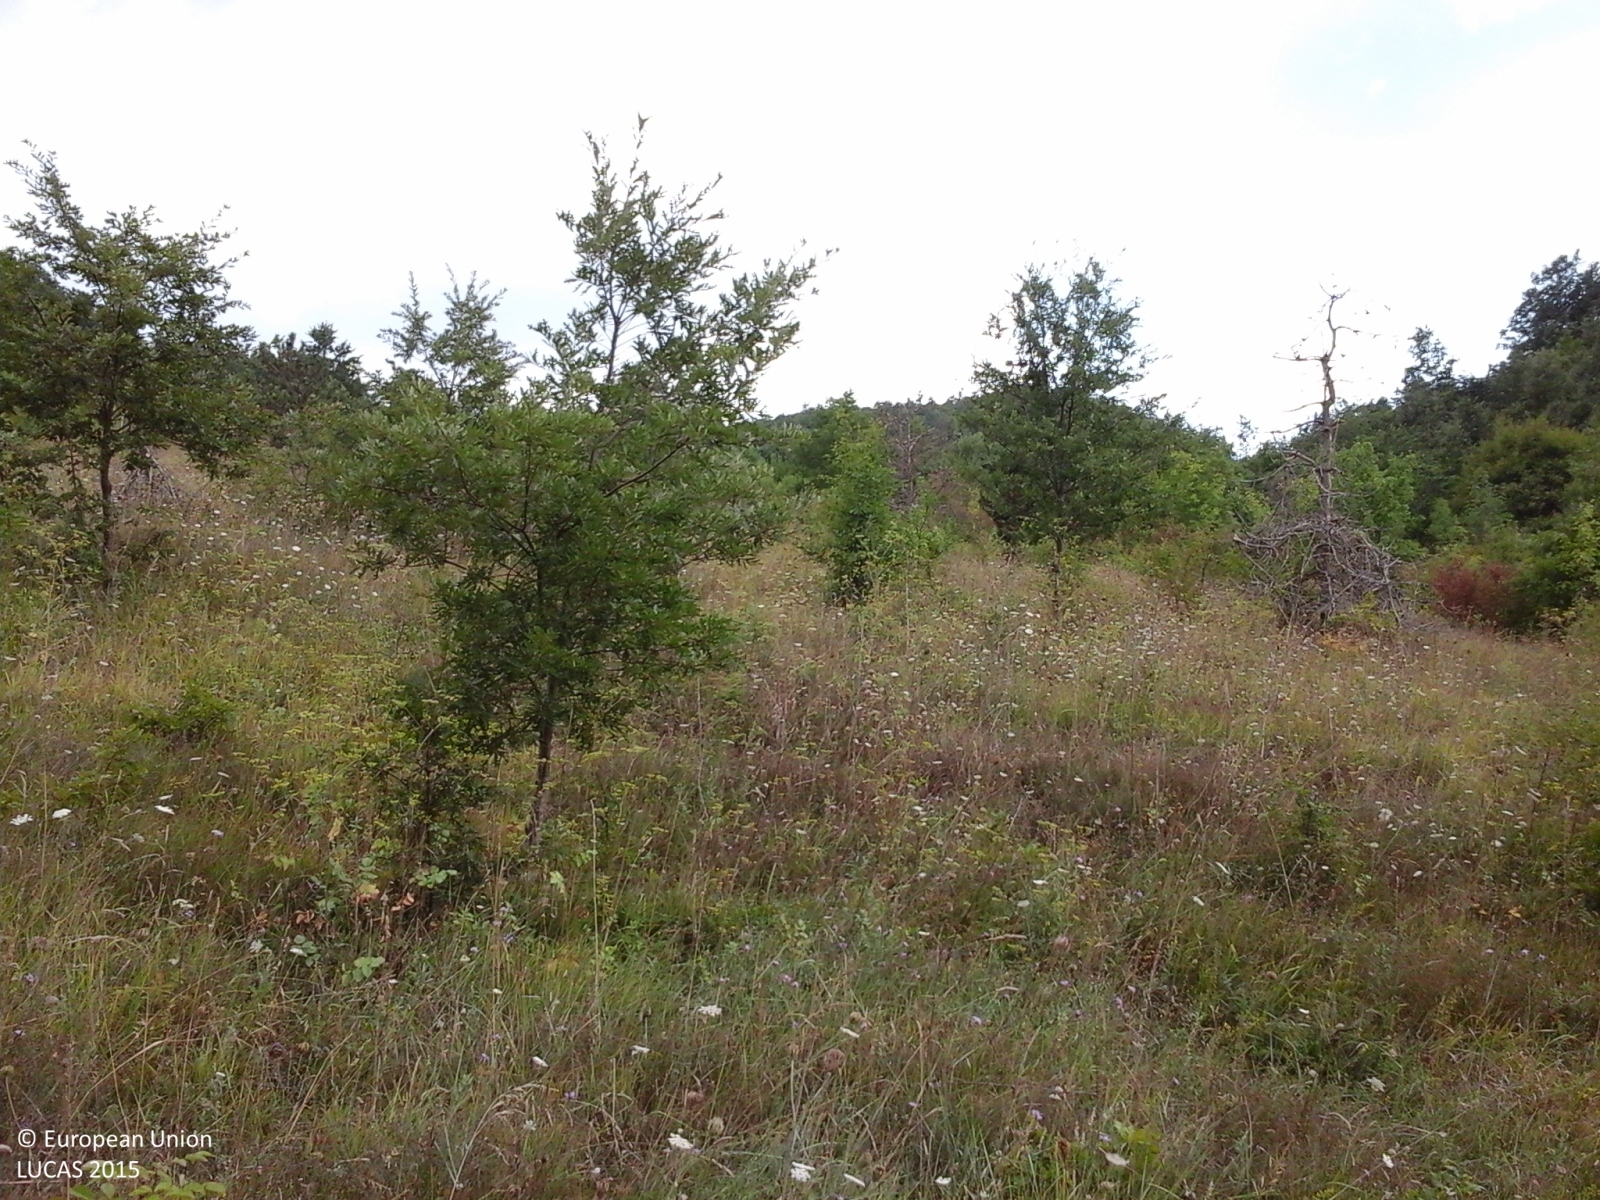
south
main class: Woodland
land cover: Broadleaved woodland
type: thermophilous deciduous forest
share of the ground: > 75 %
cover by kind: herbaceous plants 50 %, broadleaved forest trees 45 %, shrubs 5 %
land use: Agriculture (excluding fallow land and kitchen gardens)
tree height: < 5 m
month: August
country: IT
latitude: 41.6965
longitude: 14.2508
